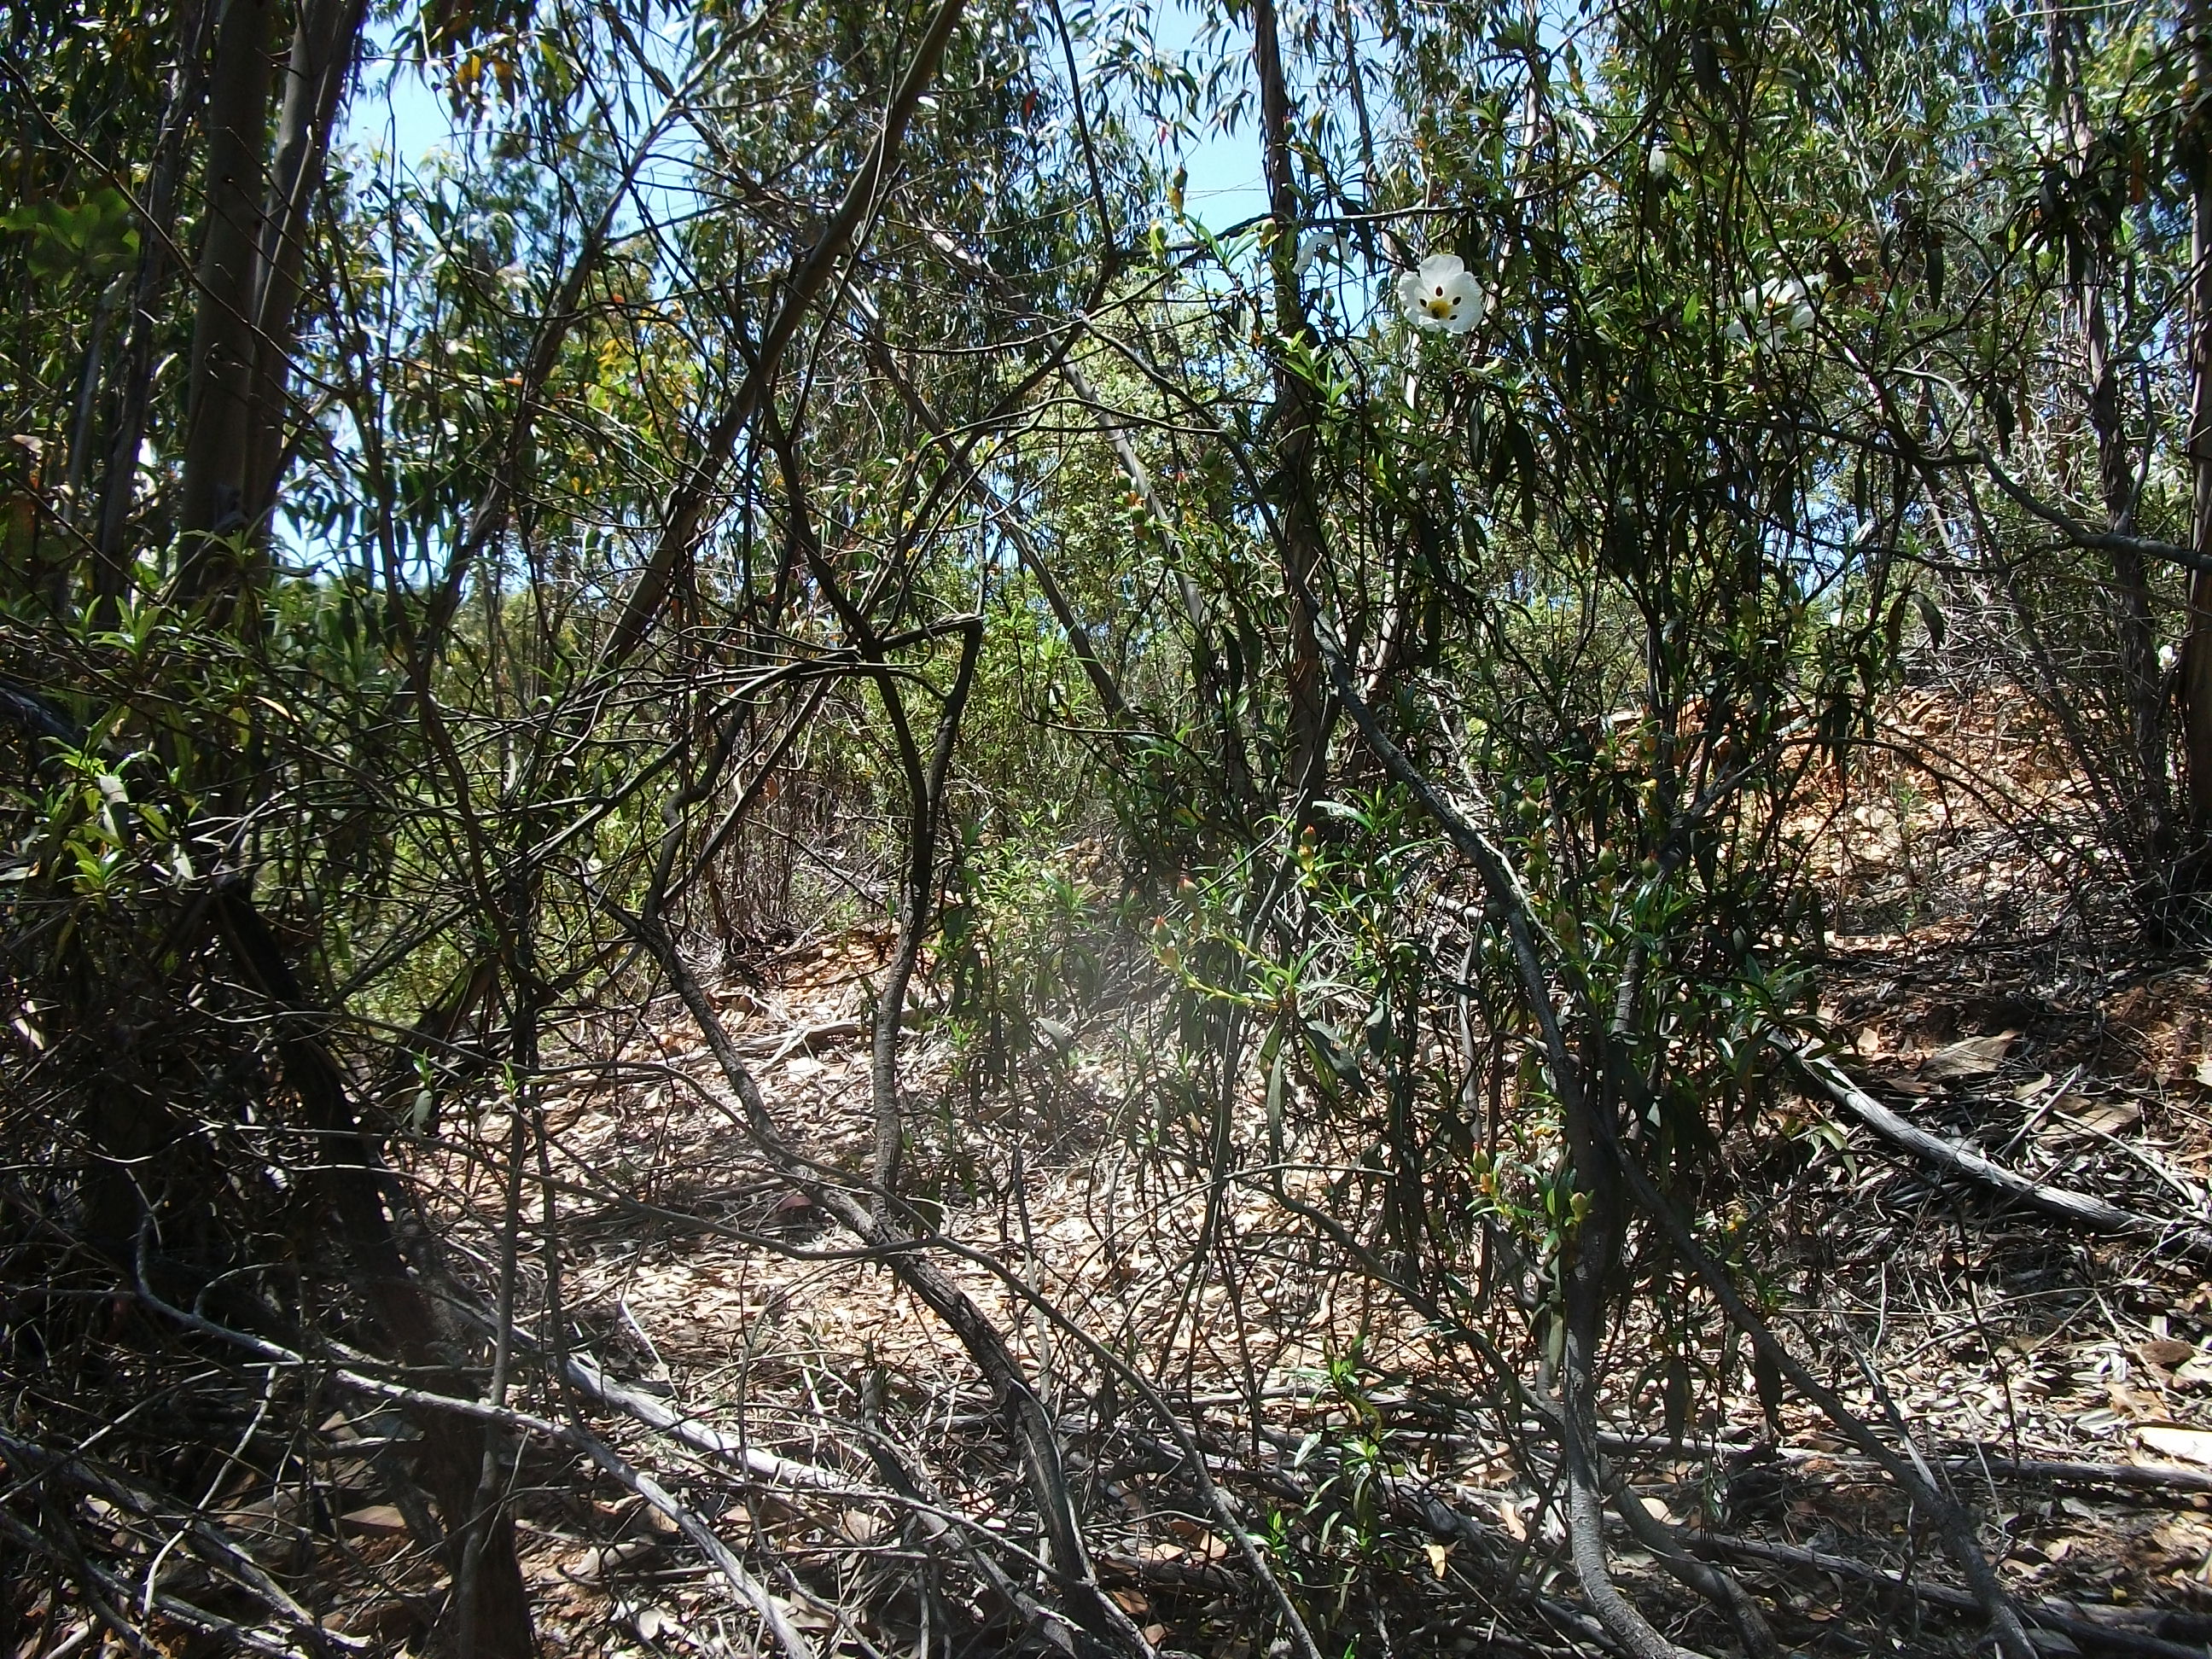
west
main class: Woodland
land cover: Broadleaved woodland
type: exotic forest
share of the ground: 50 - 75 %
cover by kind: broadleaved forest trees 60 %, shrubs 40 %
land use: Forestry
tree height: > 5 m
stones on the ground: 25 - 50 %
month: May
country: ES
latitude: 37.9216
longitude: -7.1071
